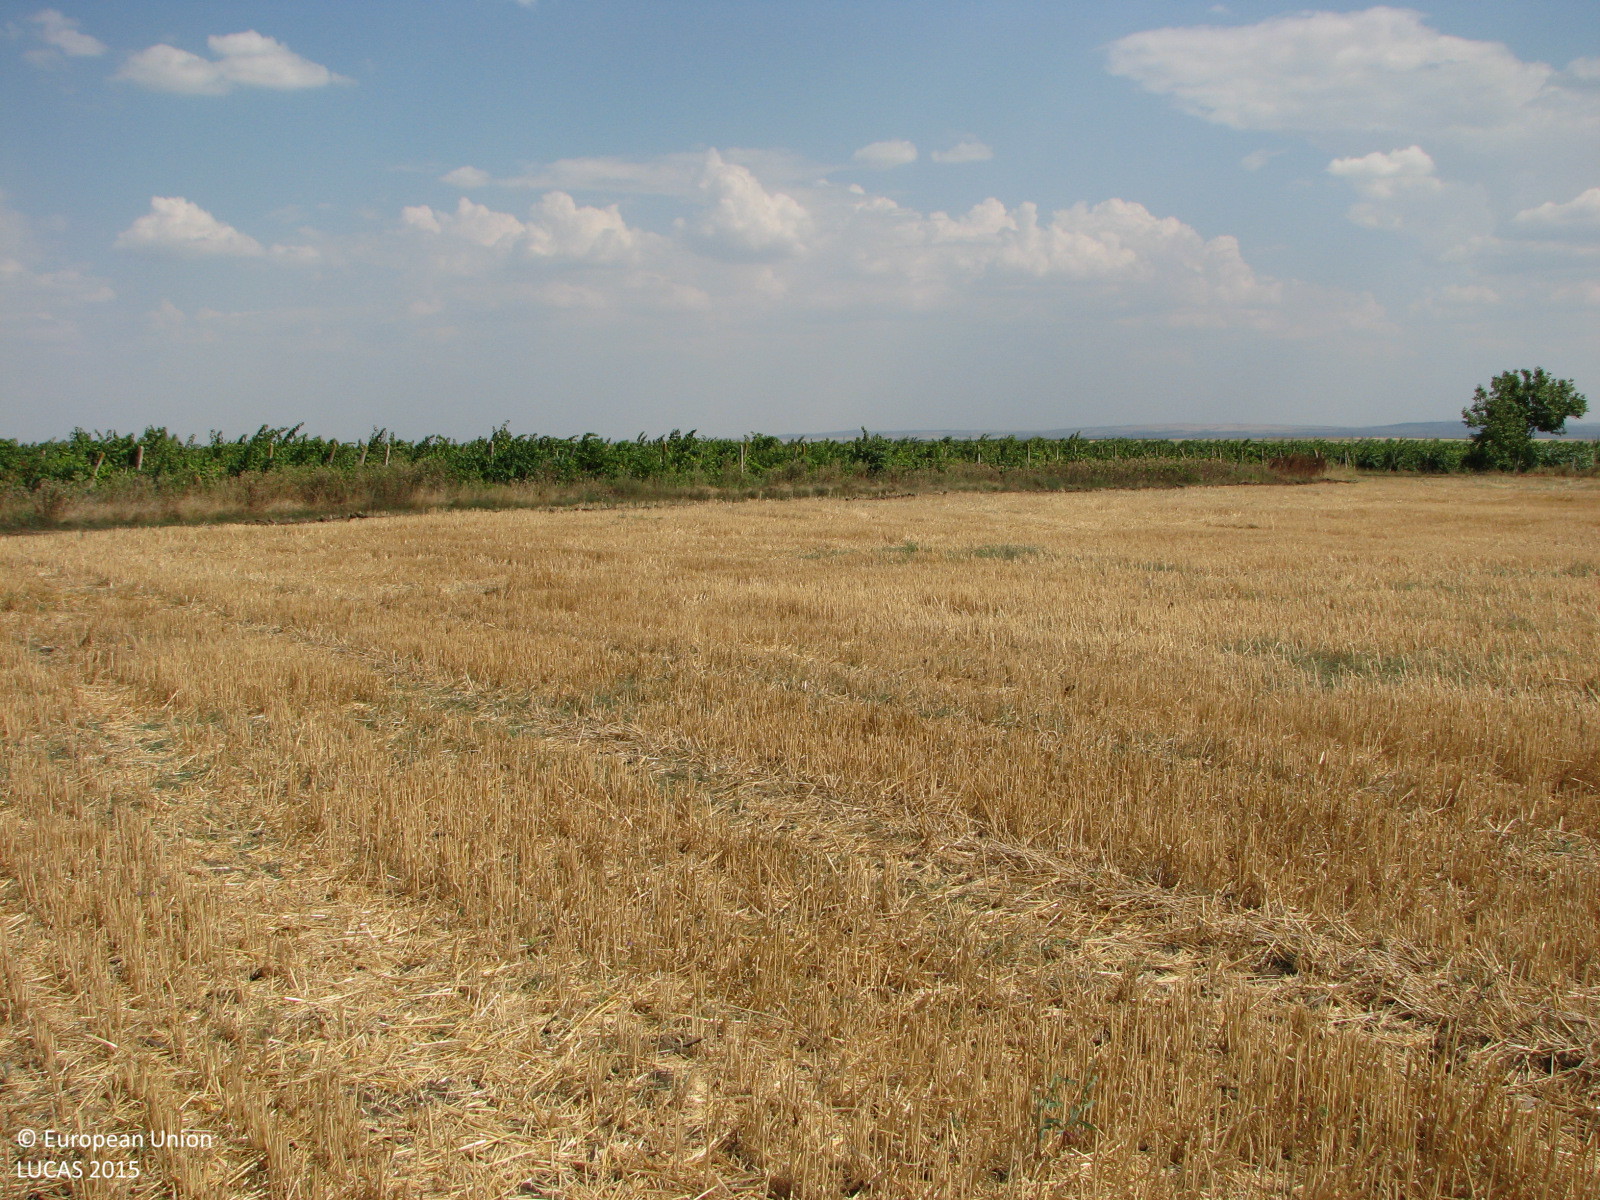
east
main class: Cropland
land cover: Common wheat
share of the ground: 50 - 75 %
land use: Agriculture (excluding fallow land and kitchen gardens)
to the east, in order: Common wheat; Tracks; Grass margins; Vineyards; Grassland with sparse tree/shrub cover
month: August
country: BG
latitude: 42.5959
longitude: 26.6098
